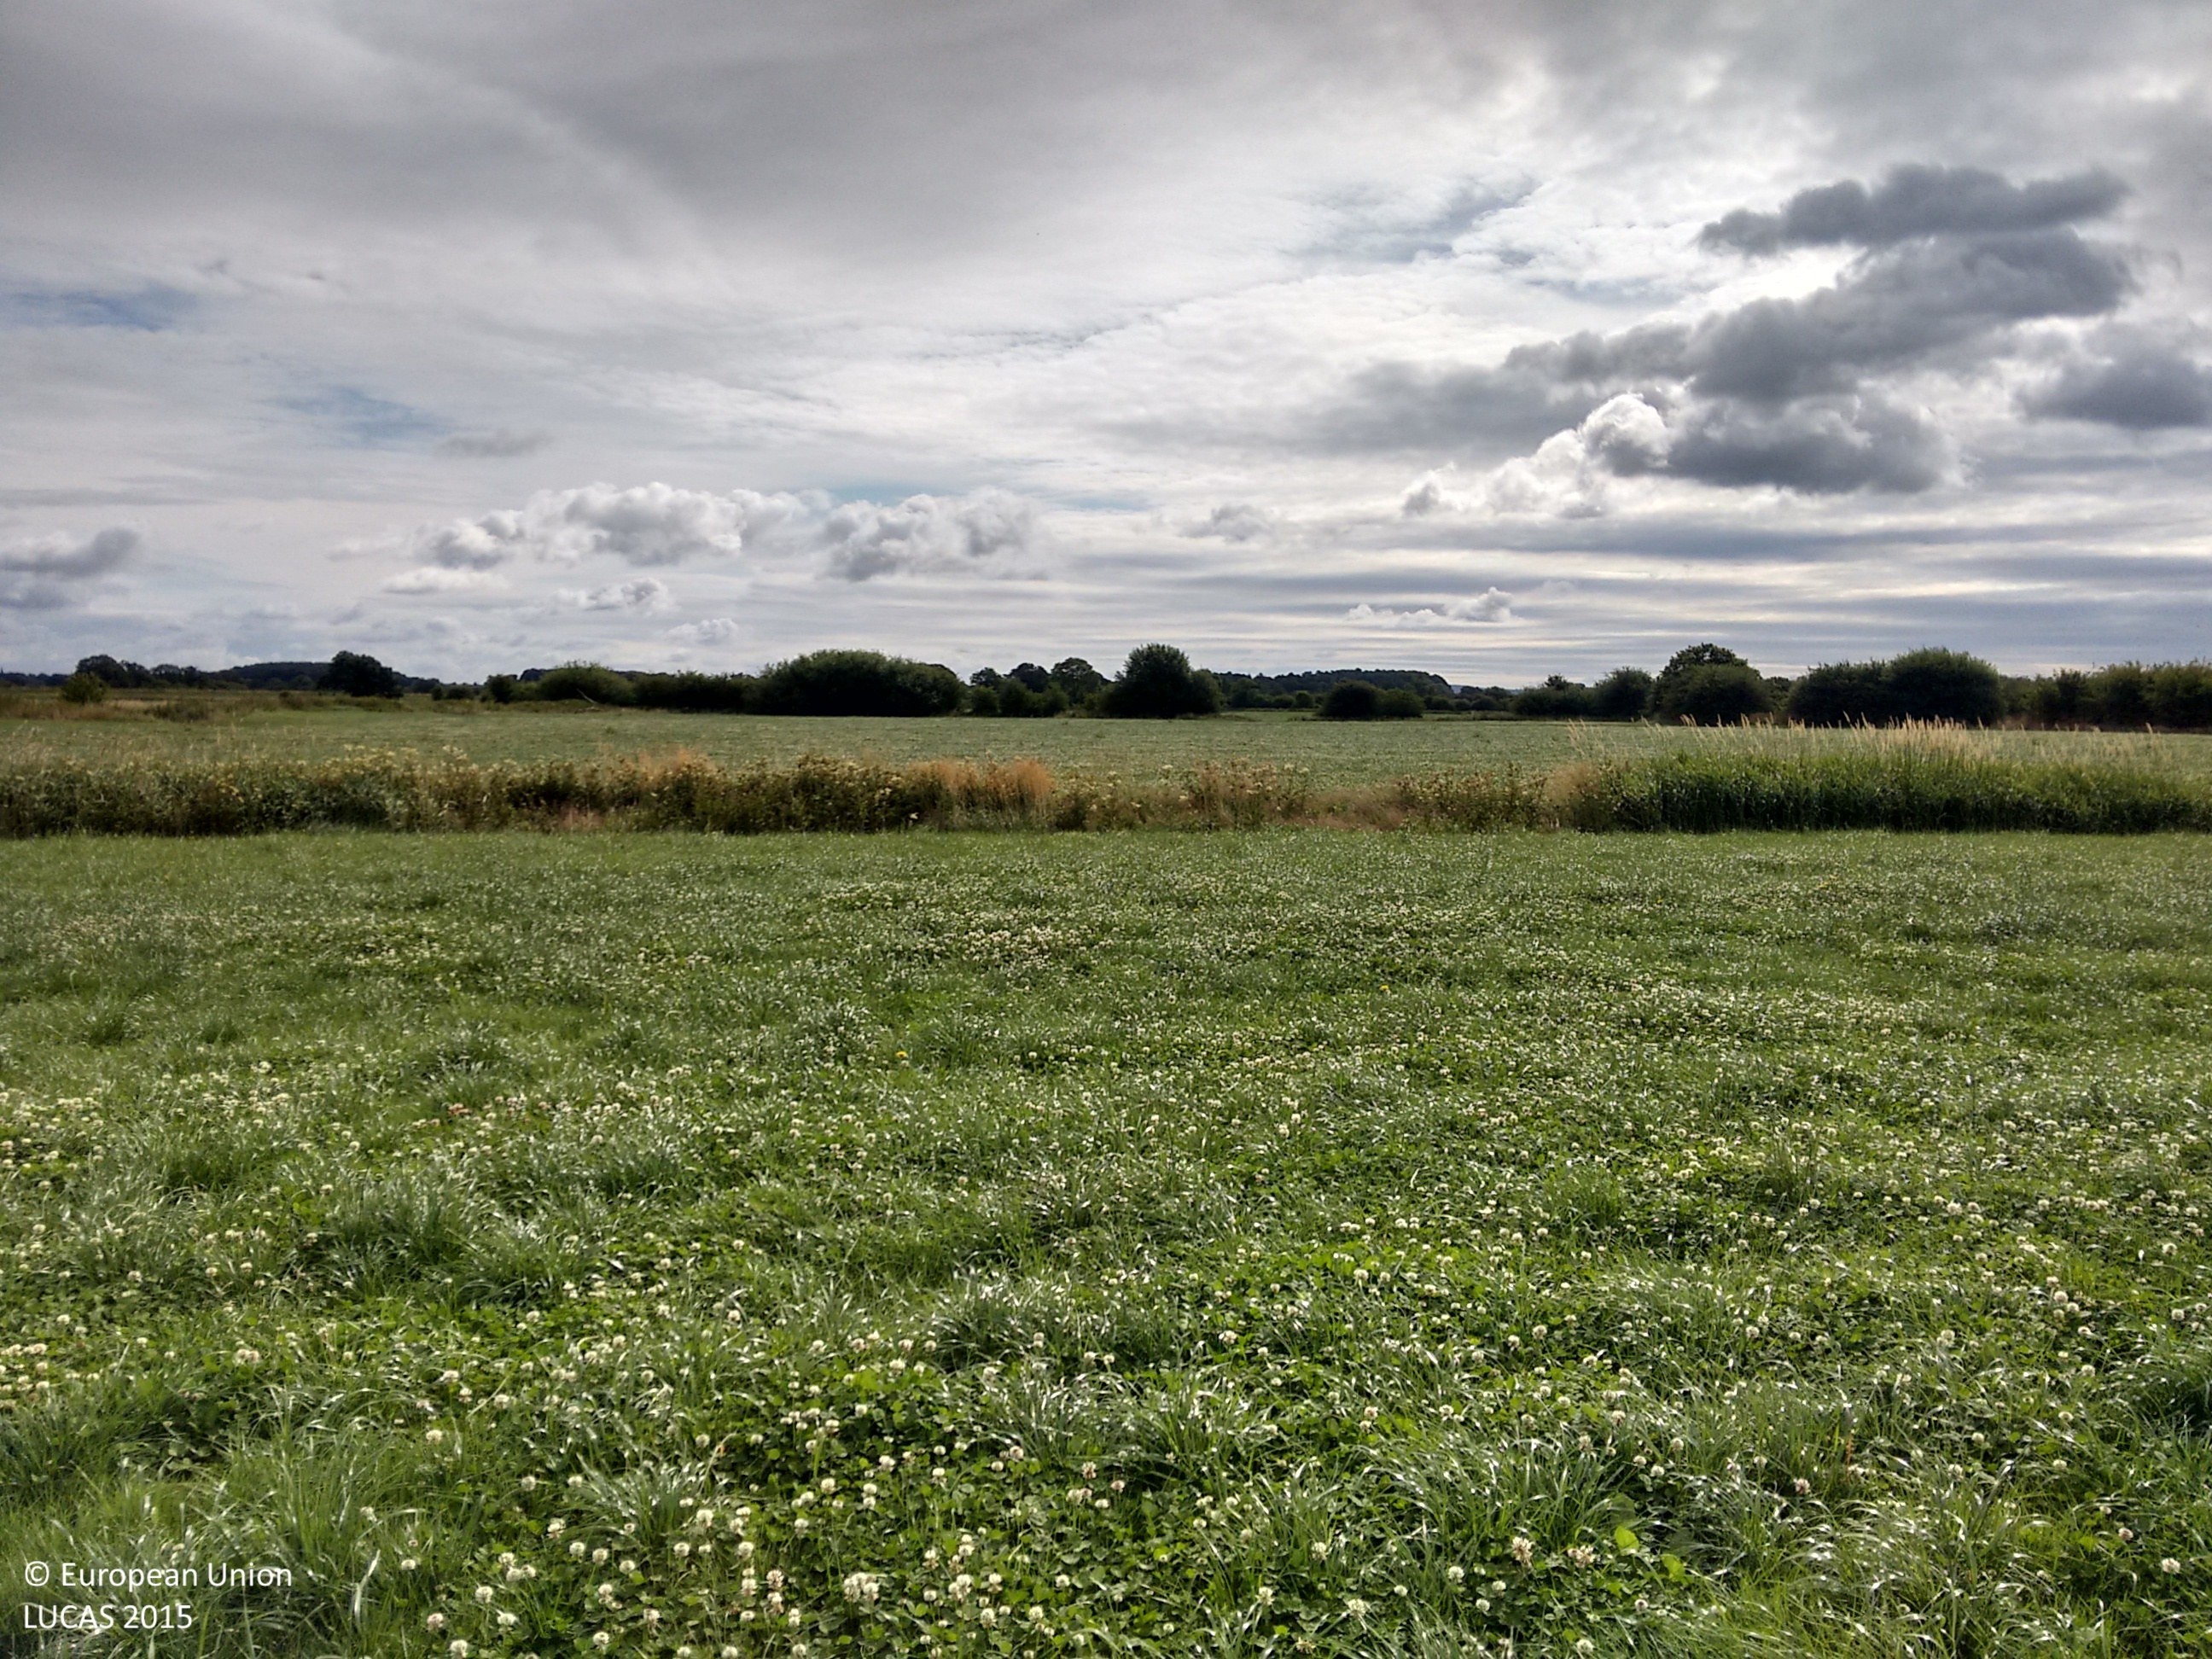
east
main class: Grassland
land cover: Grassland without tree/shrub cover
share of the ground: > 75 %
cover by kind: herbaceous plants 100 %
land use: Agriculture (excluding fallow land and kitchen gardens)
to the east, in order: Grassland without tree/shrub cover; Shruby margins; Grassland without tree/shrub cover; Rivers and streams; Abandoned hedges; Grassland without tree/shrub cover; Tracks; Grassland without tree/shrub cover
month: July
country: GB
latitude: 53.1085
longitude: -2.9047
